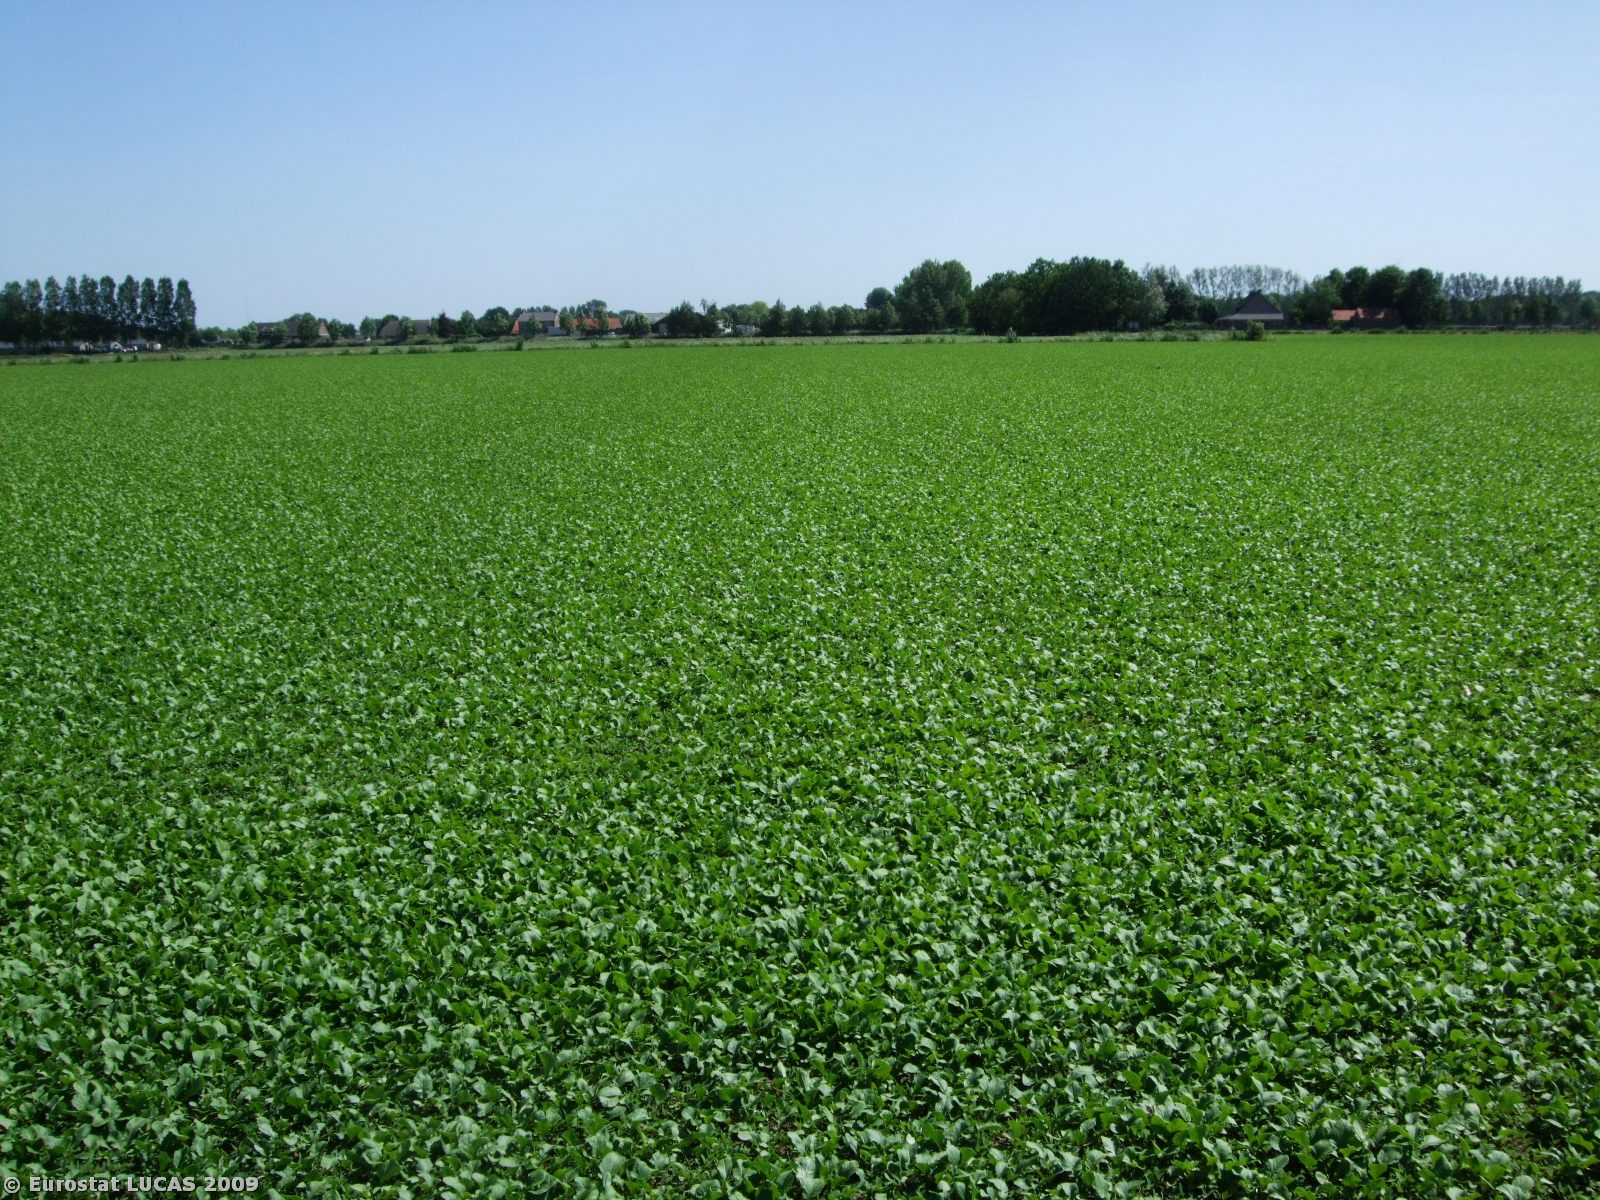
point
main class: Cropland
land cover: Other root crops
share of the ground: > 75 %
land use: Agriculture (excluding fallow land and kitchen gardens)
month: June
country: NL
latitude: 51.5882
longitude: 5.4516
